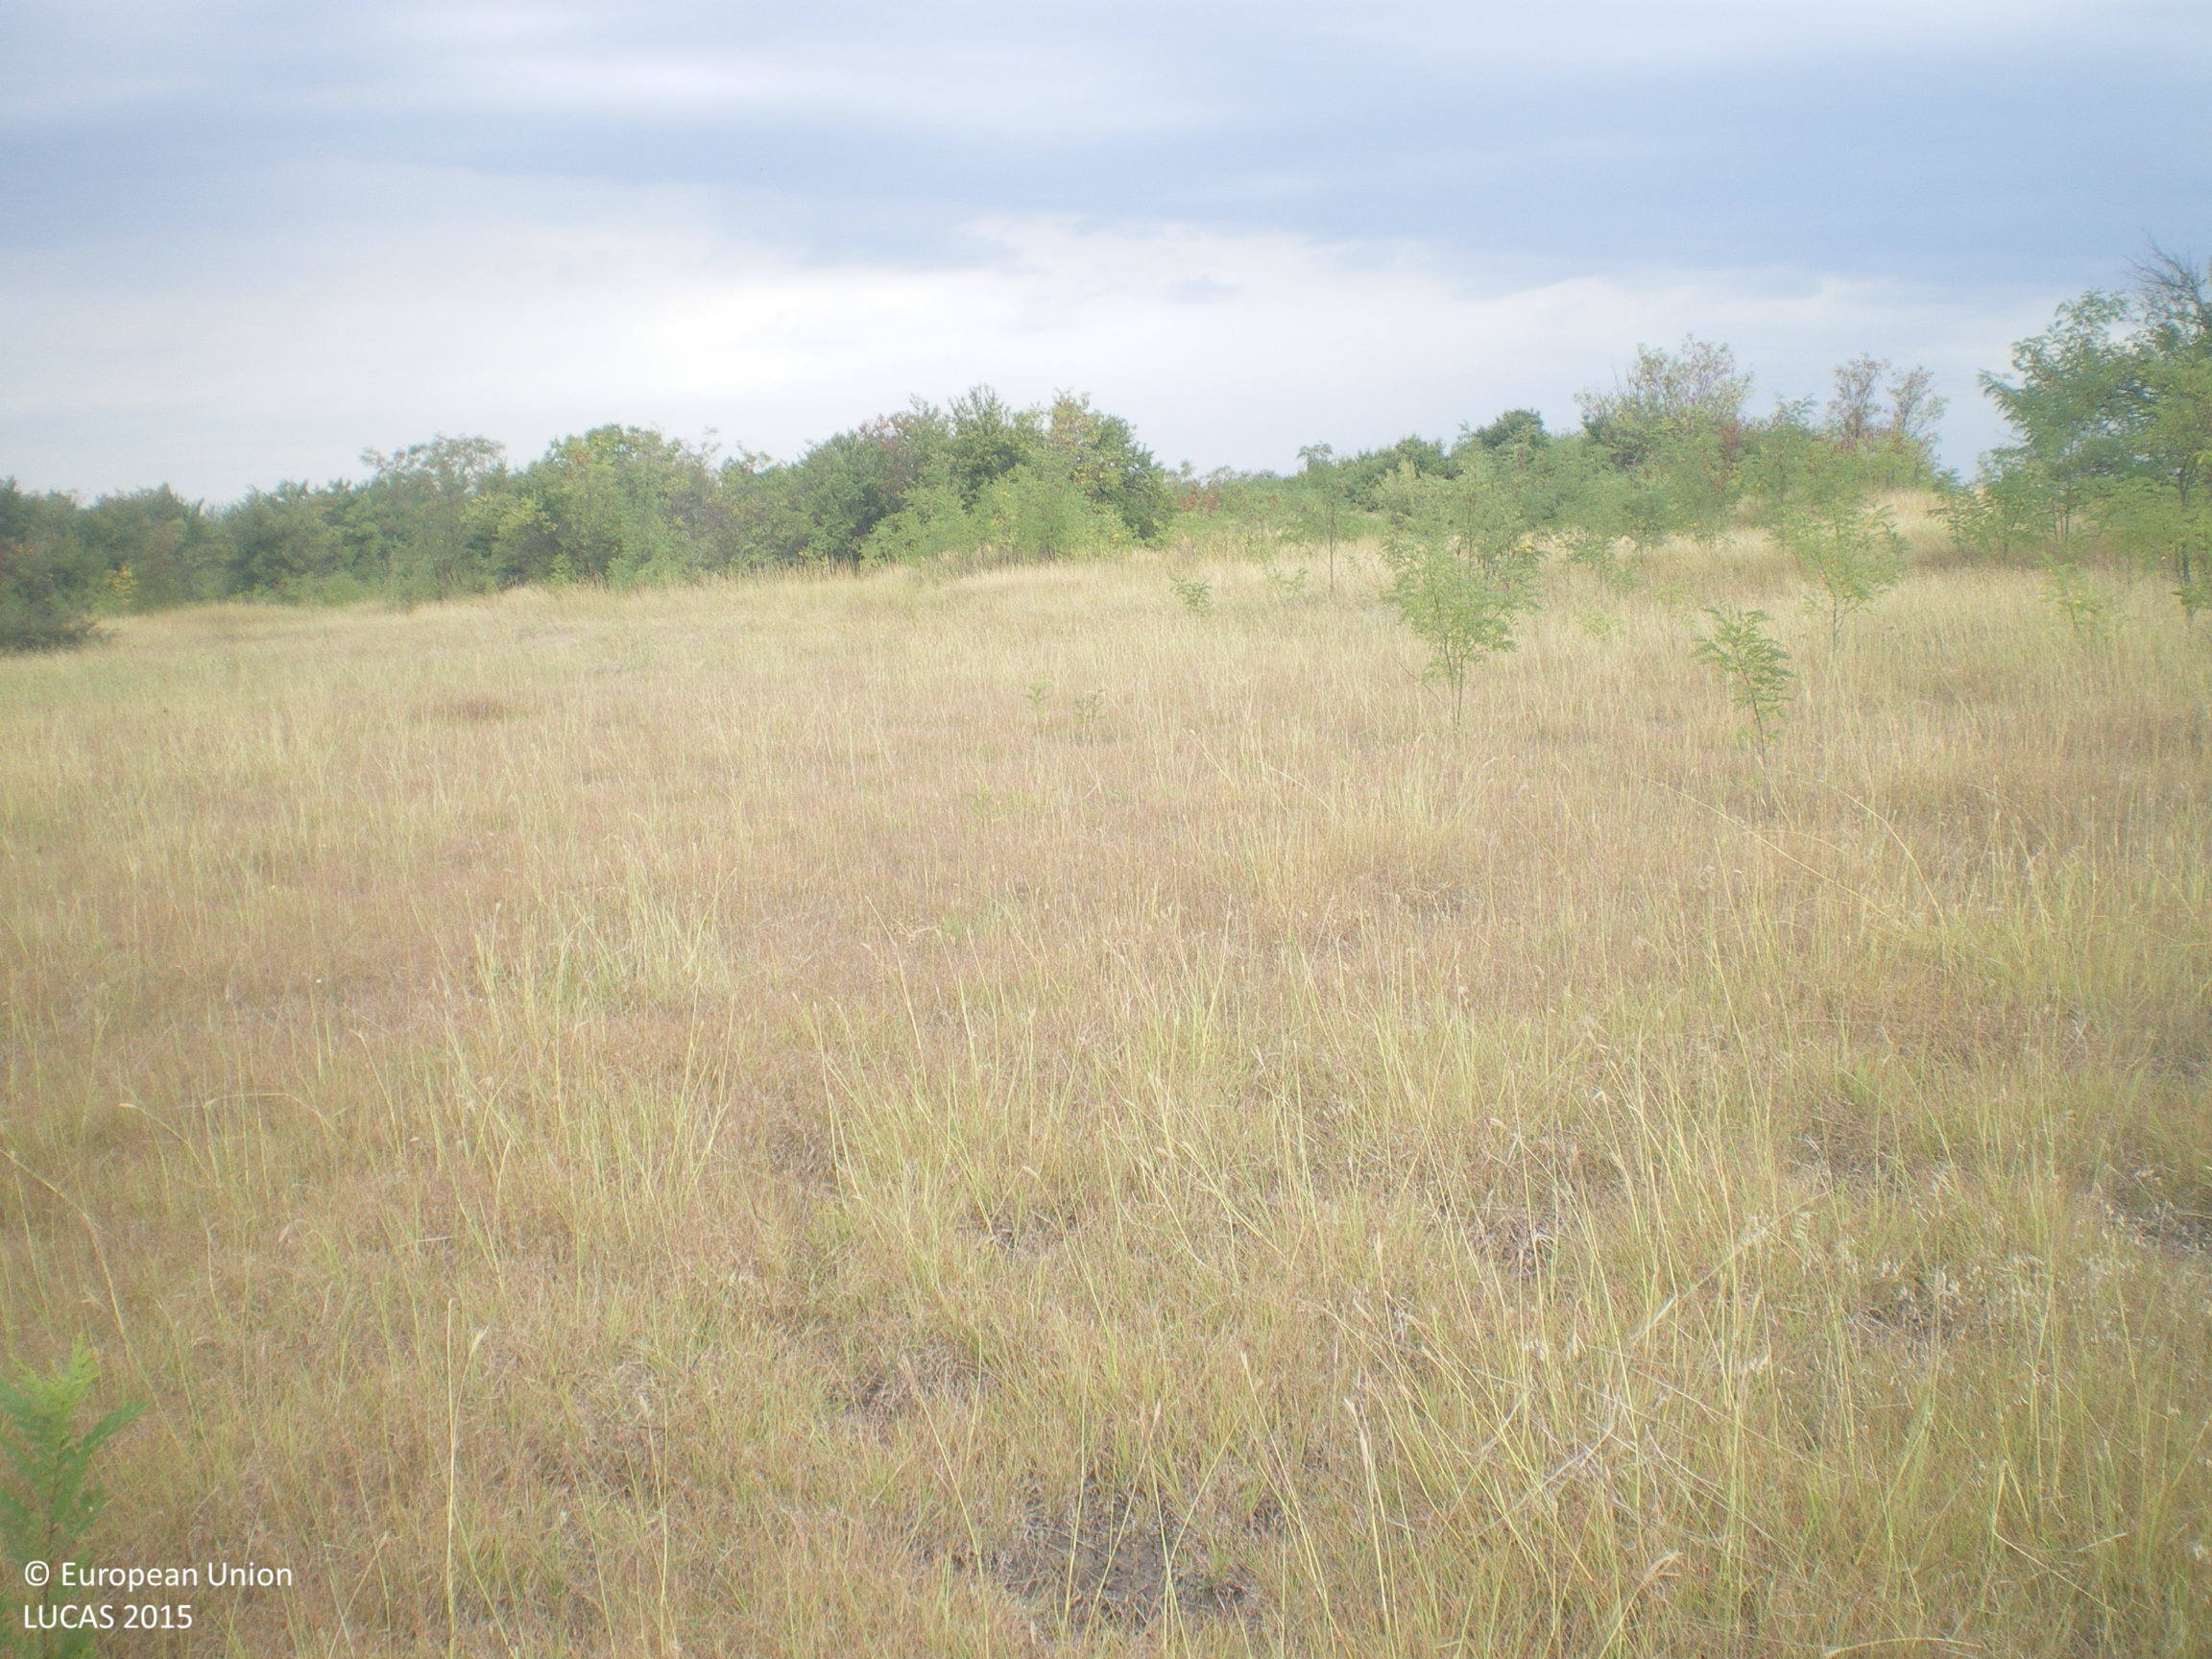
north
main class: Grassland
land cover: Grassland with sparse tree/shrub cover
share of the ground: > 75 %
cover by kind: herbaceous plants 90 %, broadleaved forest trees 5 %, shrubs 5 %
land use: Semi-natural and natural areas not in use
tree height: > 5 m
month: September
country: BG
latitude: 42.2594
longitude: 25.9692
